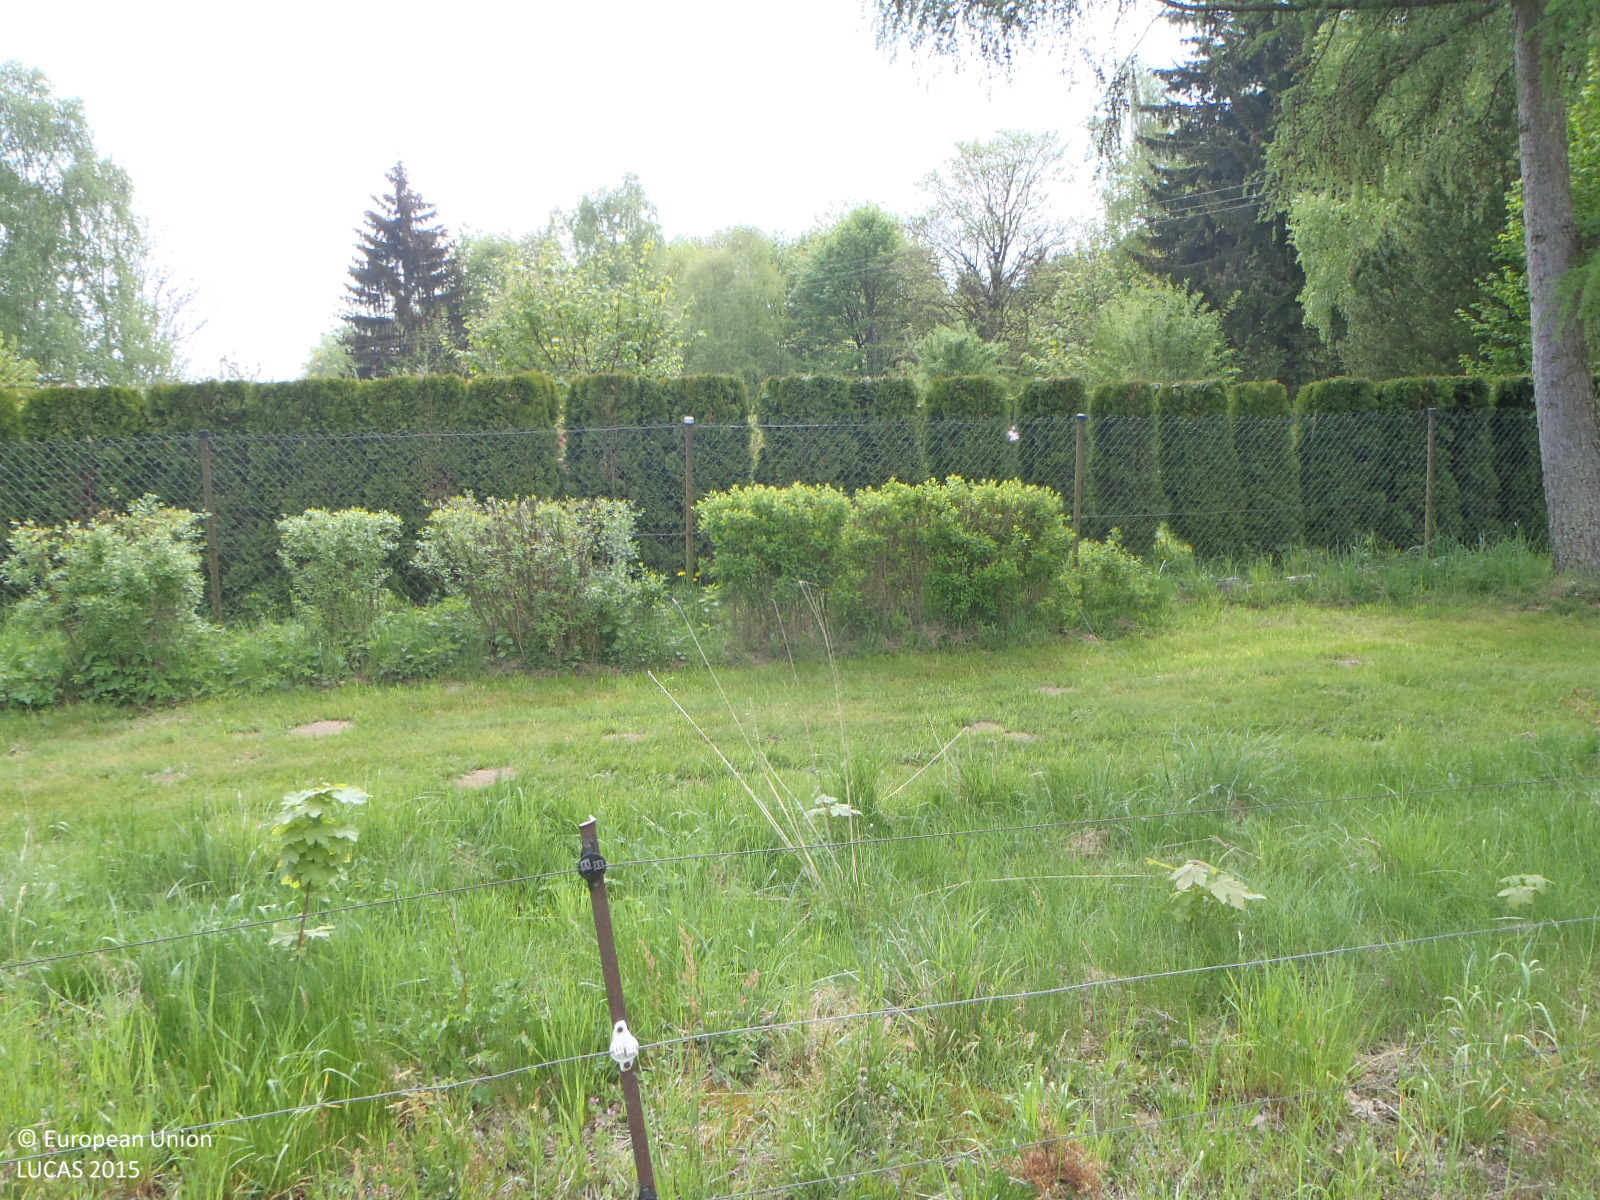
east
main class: Grassland
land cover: Grassland without tree/shrub cover
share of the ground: > 75 %
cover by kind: herbaceous plants 100 %
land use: Agriculture (excluding fallow land and kitchen gardens)
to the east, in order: Grassland without tree/shrub cover; Fences; Abandoned hedges; Grassland without tree/shrub cover; Artificial constructions in urban areas; Grassland with sparse tree/shrub cover; Broadleaved woodland; Tracks; Broadleaved woodland; Grassland without tree/shrub cover; Electric lines; Grassland without tree/shrub cover; Broadleaved woodland; Ditches and canals; Dry stone walls; Broadleaved woodland; Other mixed woodland
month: May
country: CZ
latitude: 49.0607
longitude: 15.1071
